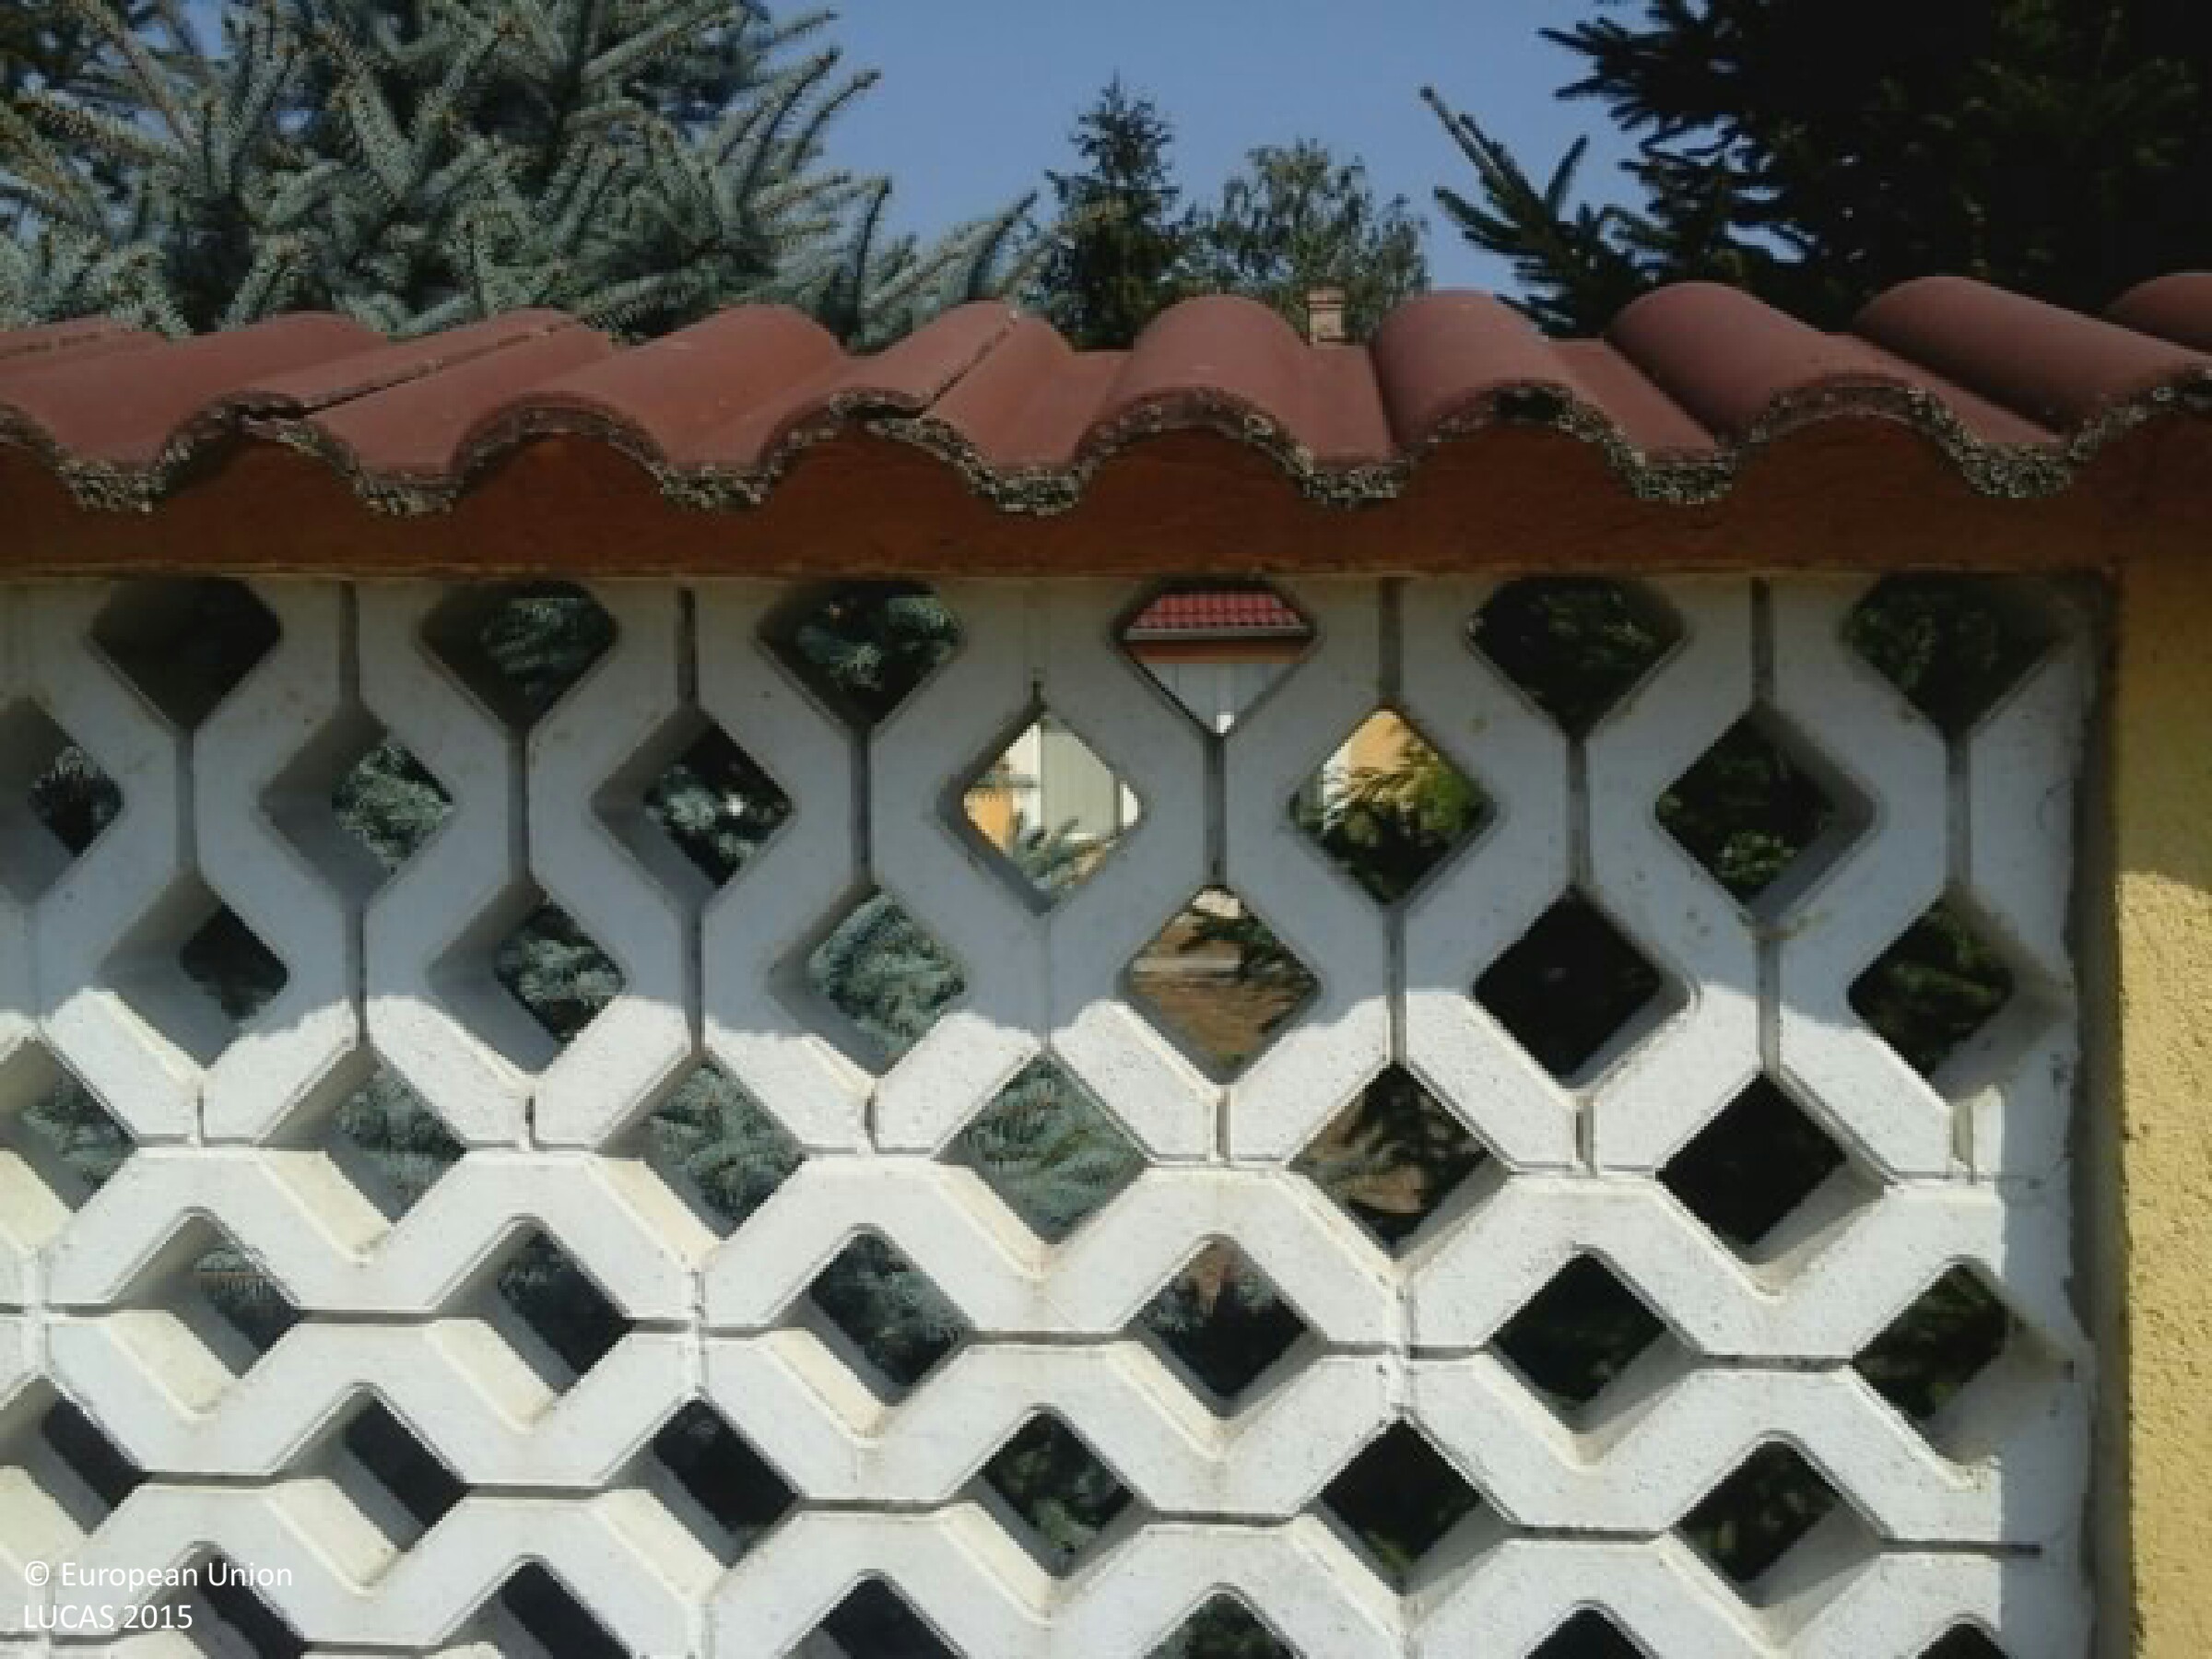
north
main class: Grassland
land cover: Grassland with sparse tree/shrub cover
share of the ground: > 75 %
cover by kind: herbaceous plants 85 %, shrubs 10 %, broadleaved forest trees 5 %
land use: Residential
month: August
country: HU
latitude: 46.9011
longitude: 18.9279
